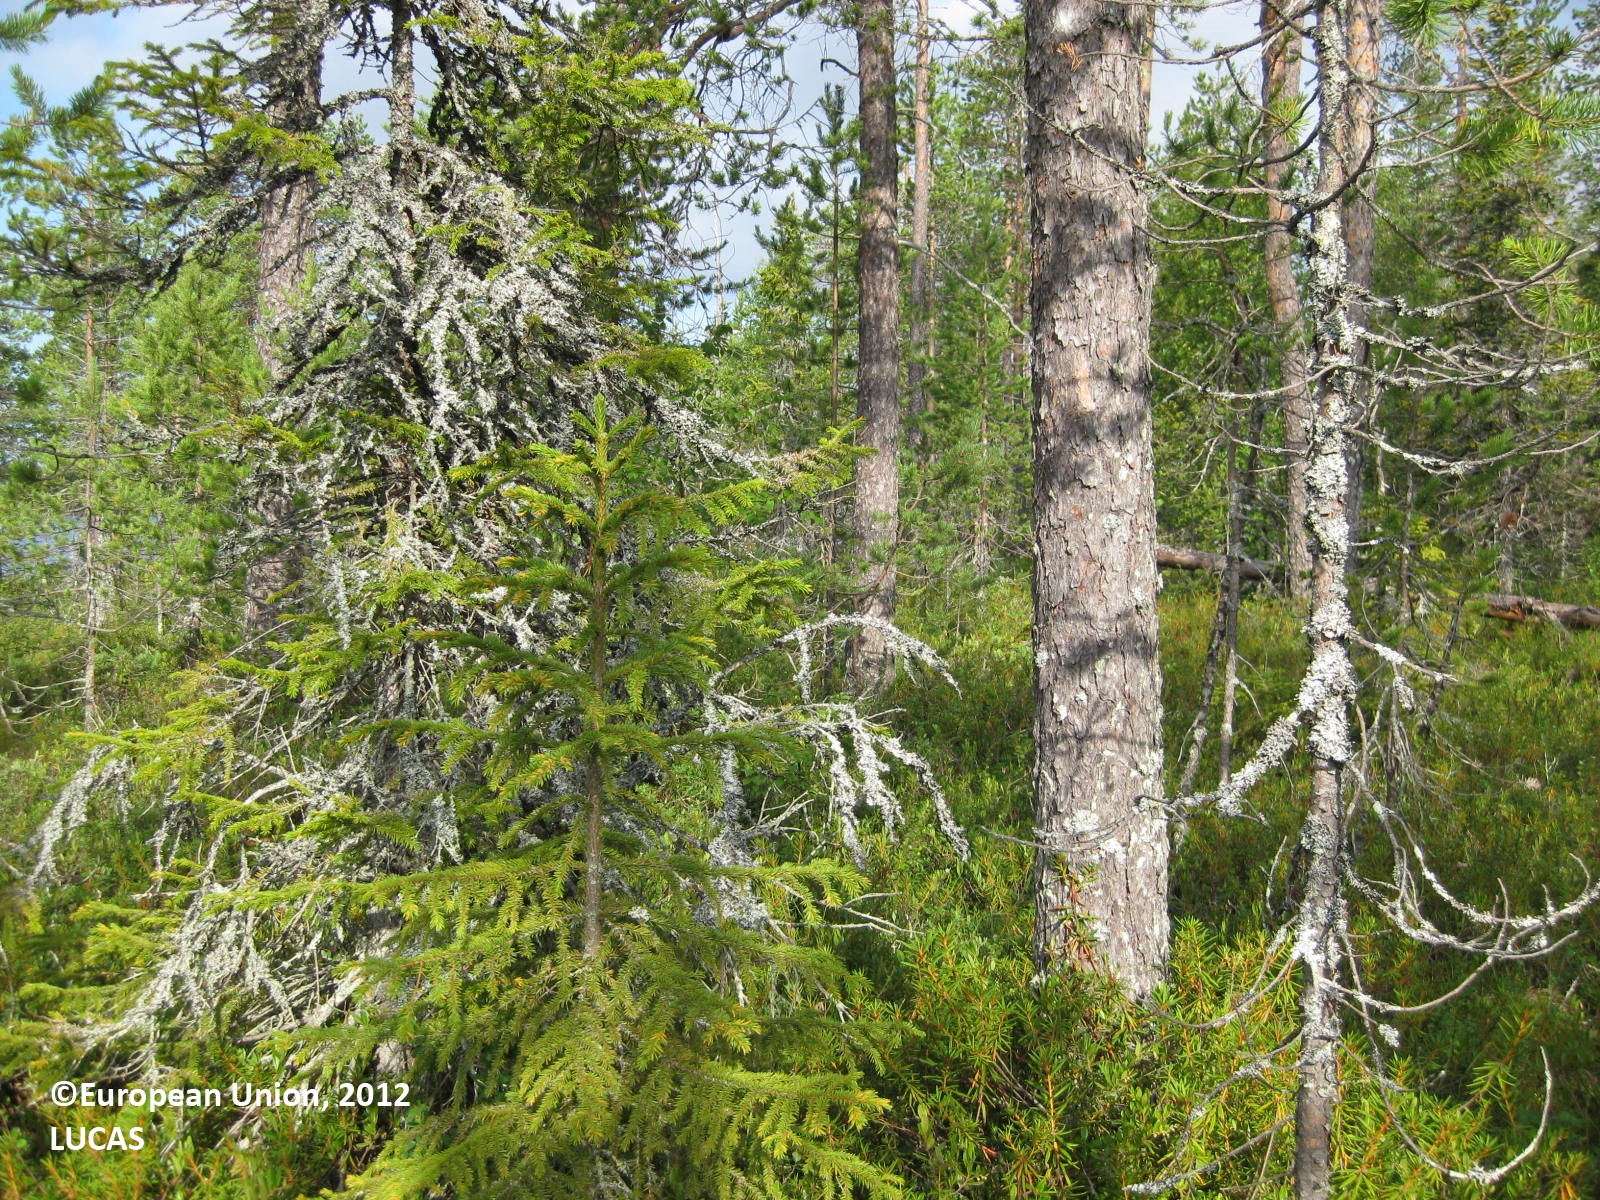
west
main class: Woodland
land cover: Pine dominated coniferous woodland
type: boreal forest
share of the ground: 50 - 75 %
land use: Forestry
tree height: > 5 m
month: July
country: FI
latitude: 65.7679
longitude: 28.6120
